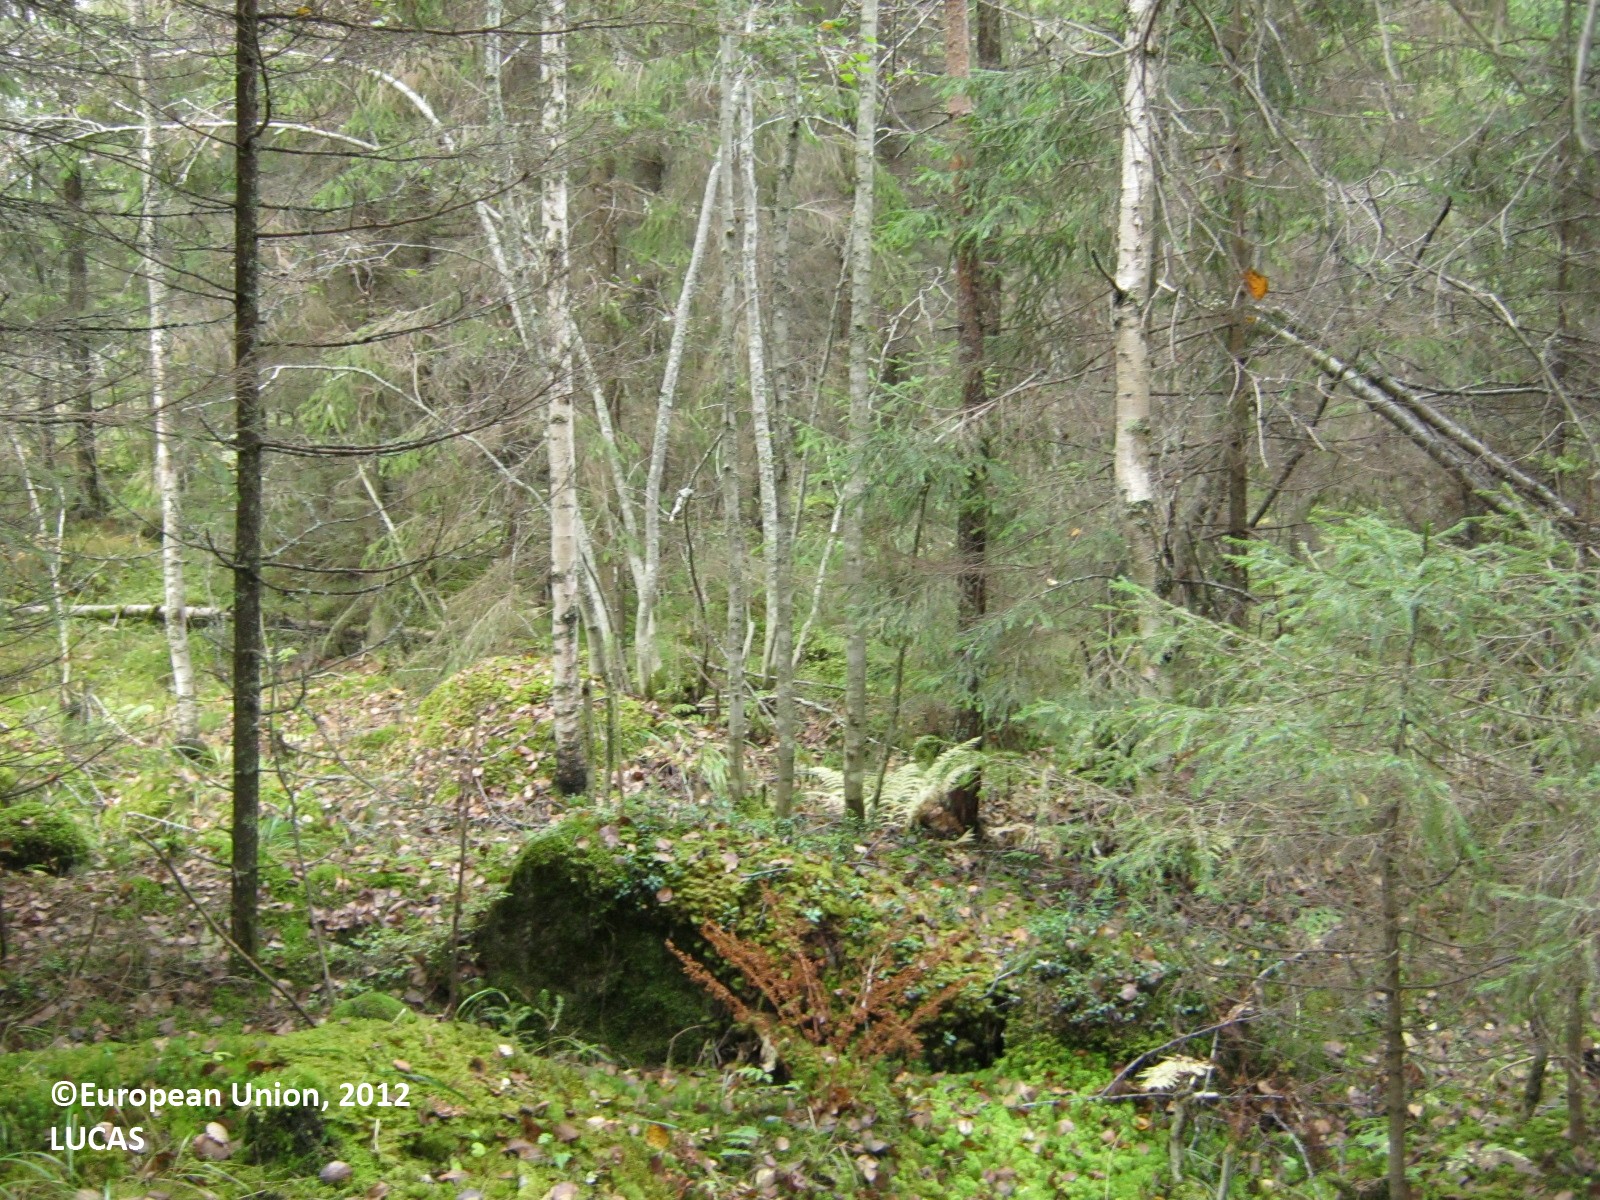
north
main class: Woodland
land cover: Spruce dominated coniferous woodland
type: boreal forest
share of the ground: 50 - 75 %
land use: Forestry
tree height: > 5 m
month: September
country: FI
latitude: 62.5238
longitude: 27.4767
